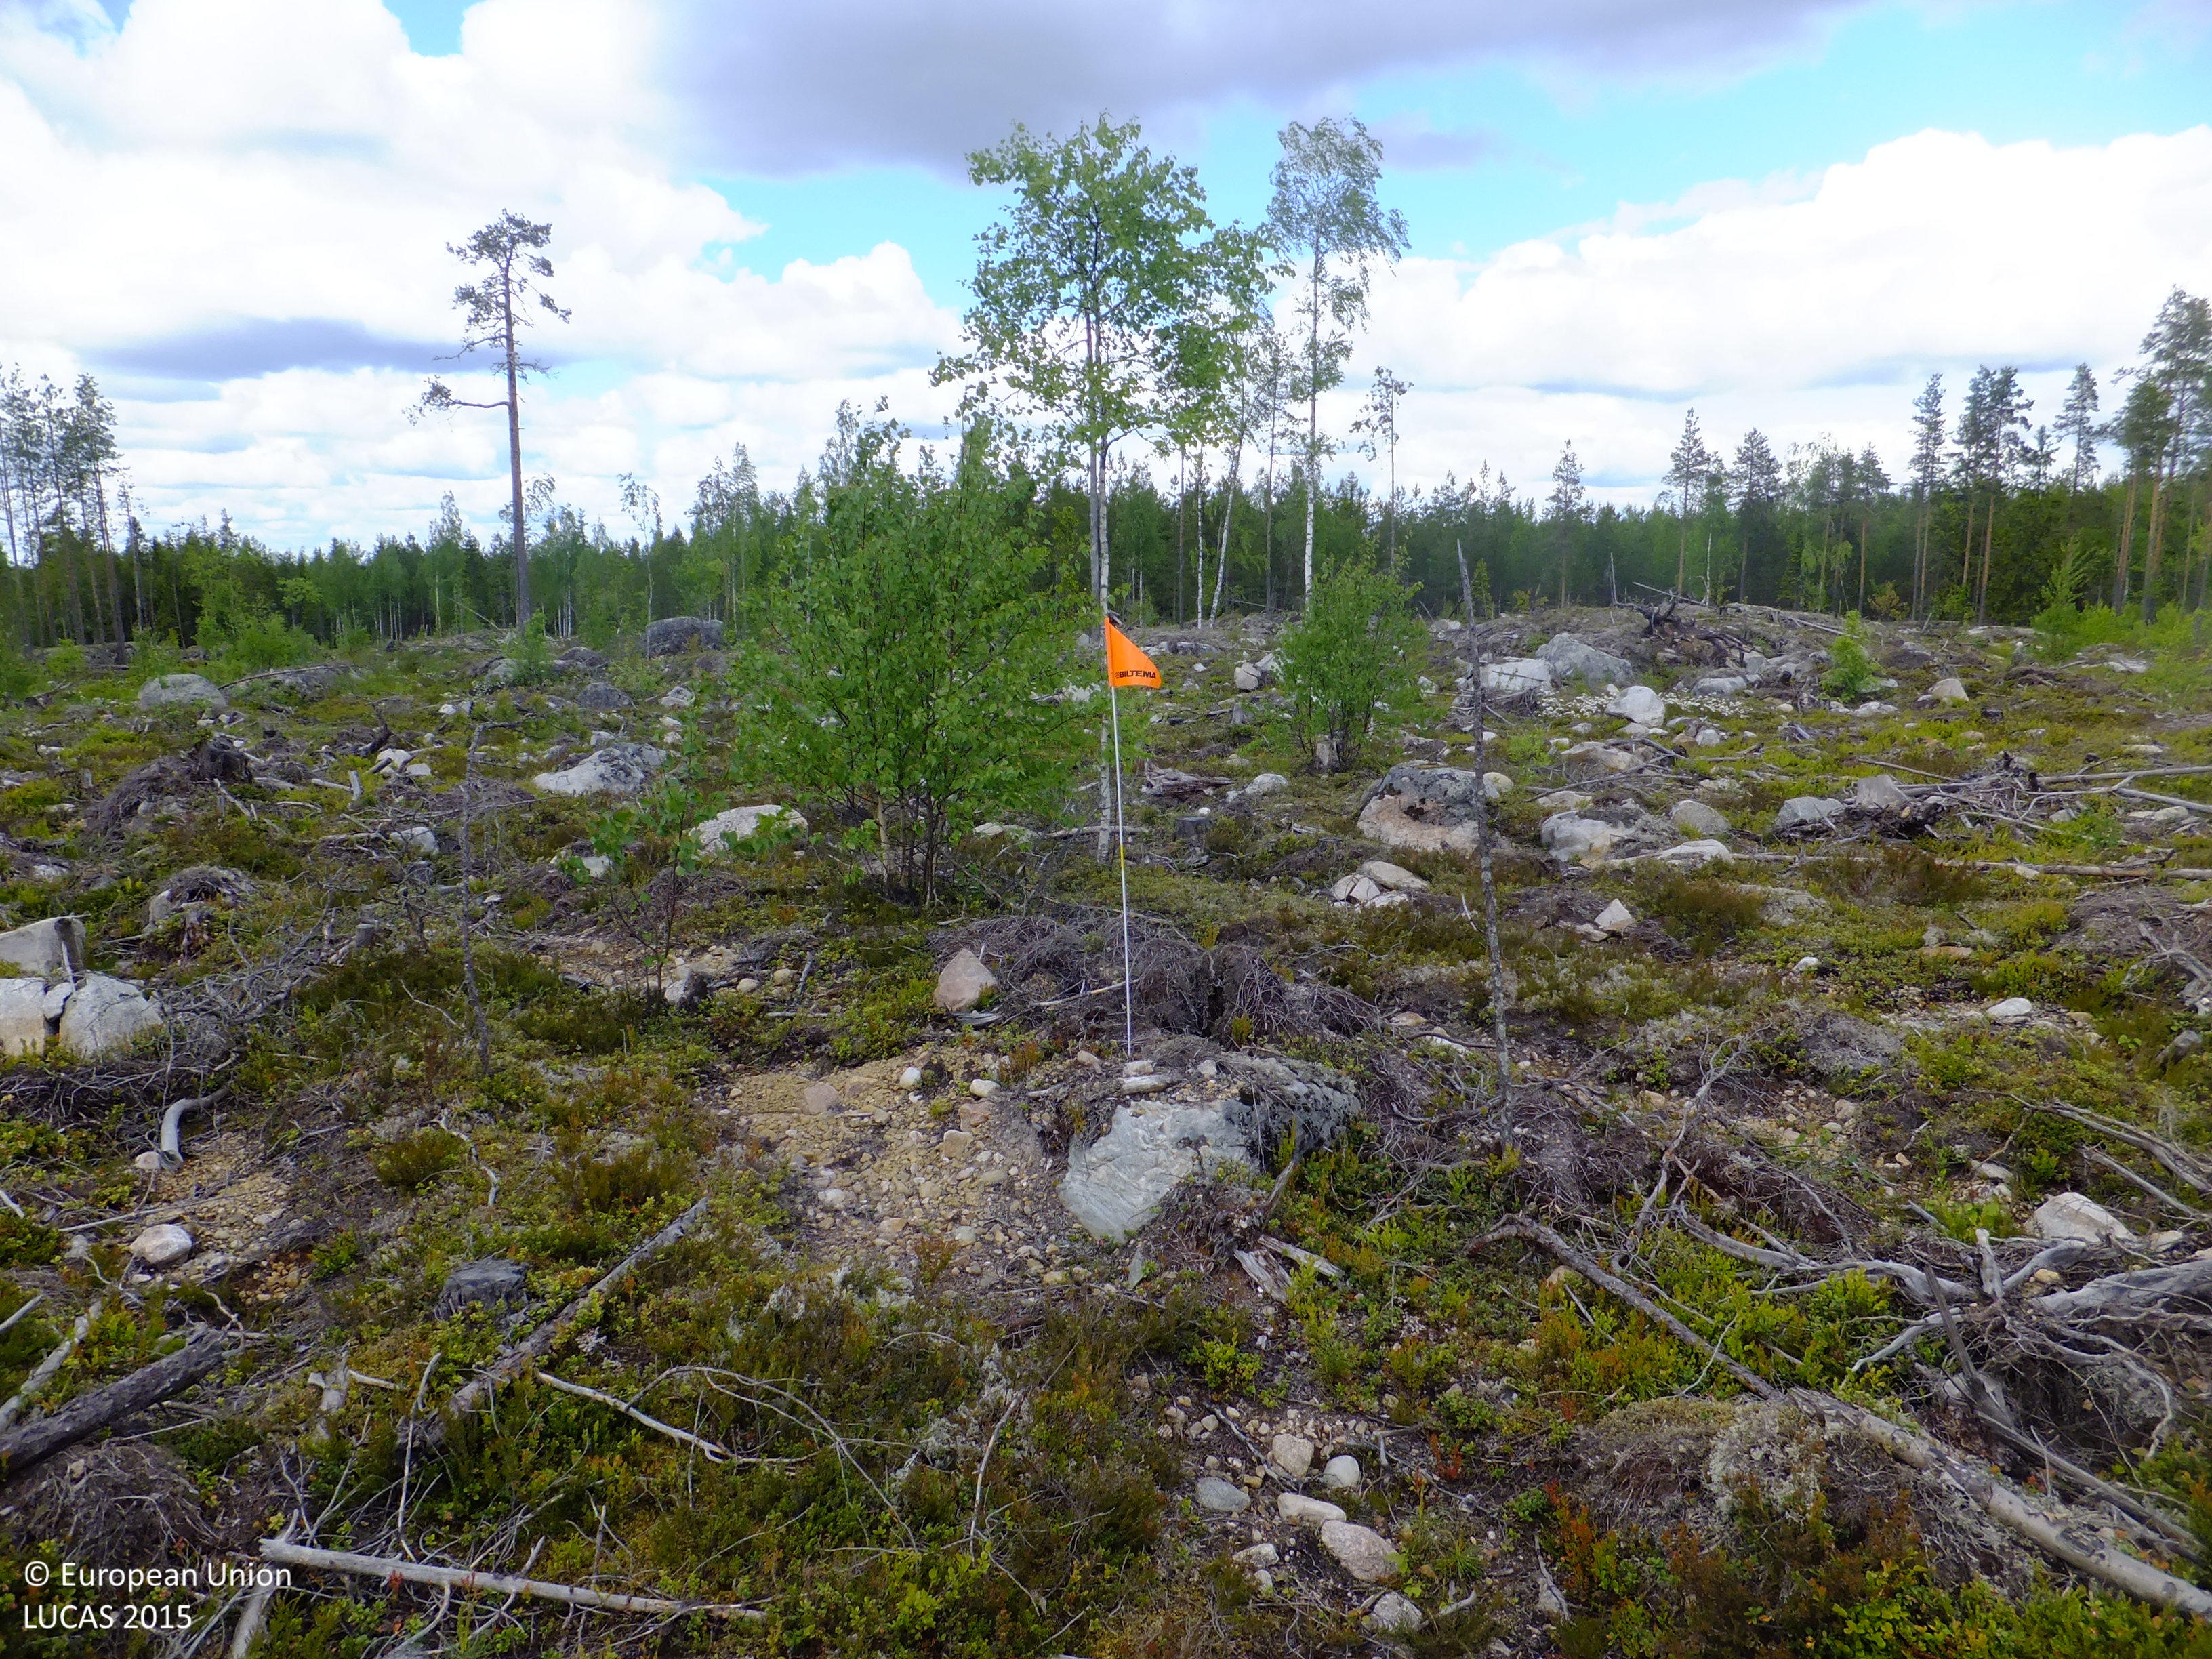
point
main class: Shrubland
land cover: Shrubland with sparse tree cover
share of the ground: 50 - 75 %
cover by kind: shrubs 55 %, lichens and mosses 20 %, consolidated bare surface 20 %, broadleaved forest trees 5 %
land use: Forestry
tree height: > 5 m
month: June
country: FI
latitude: 63.4876
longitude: 24.8863
